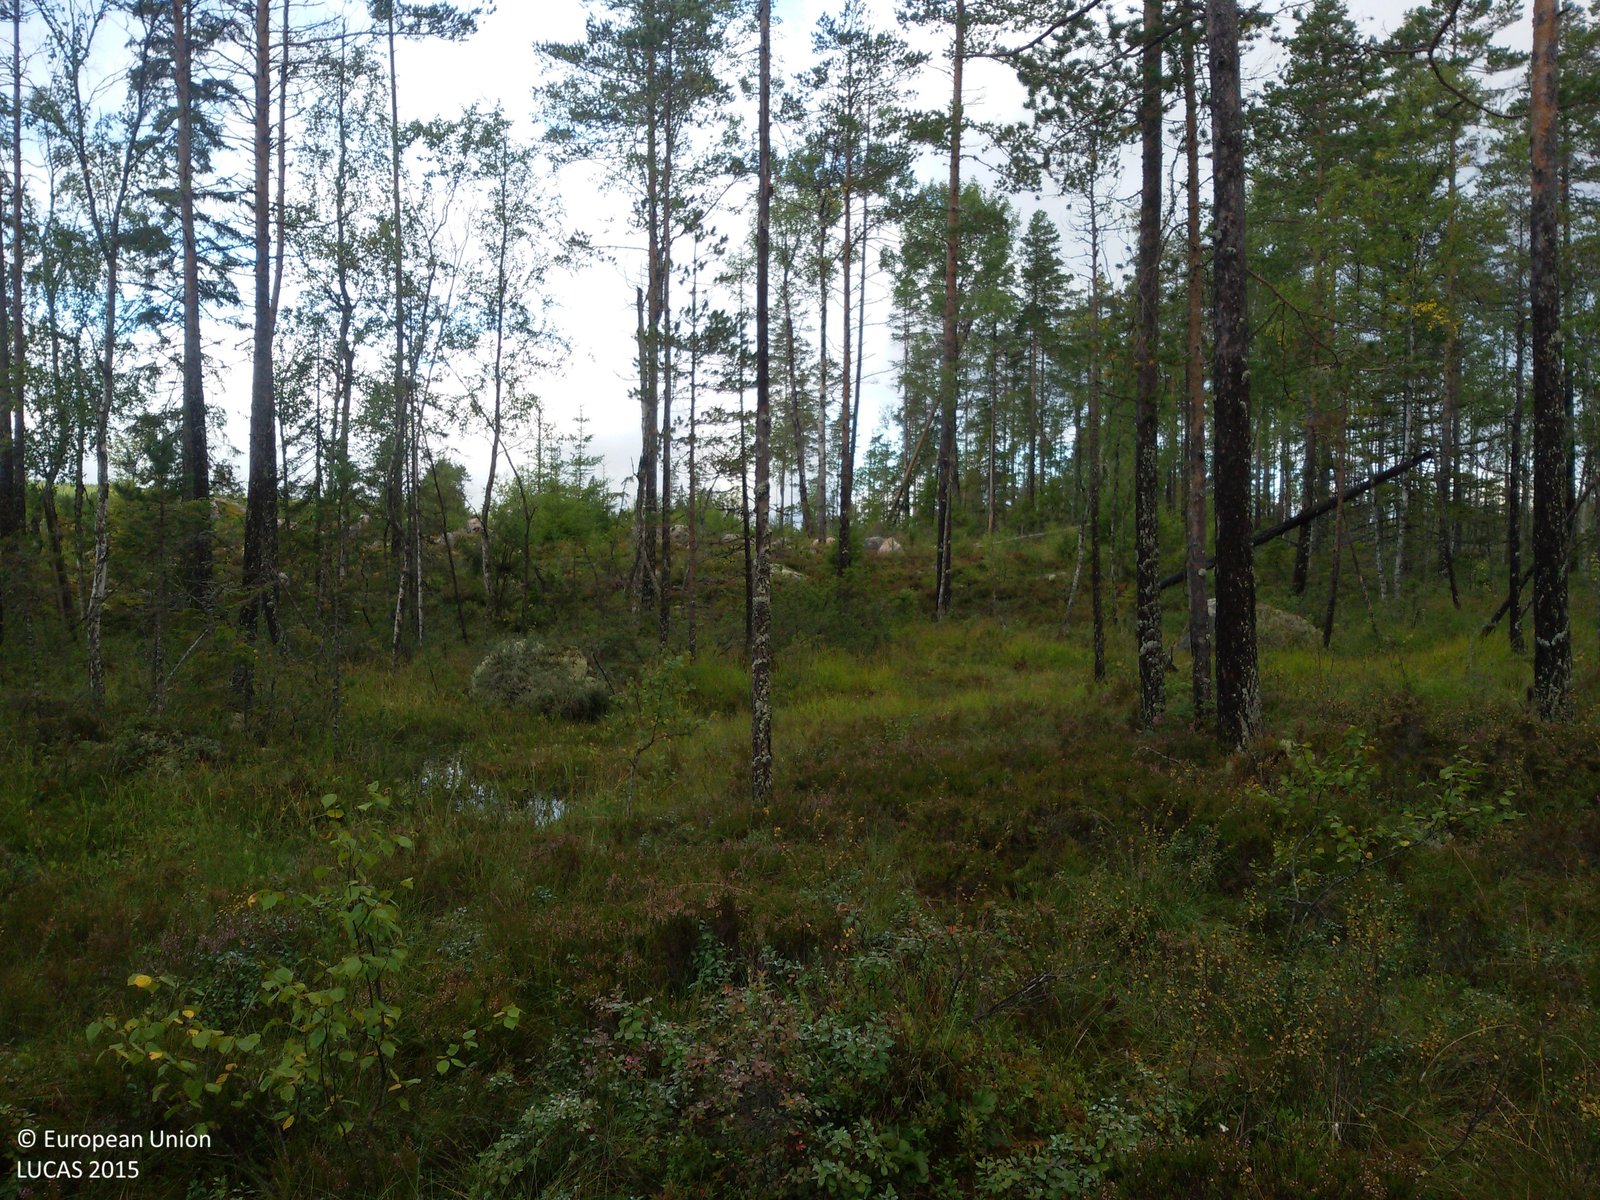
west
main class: Woodland
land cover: Pine dominated mixed woodland
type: boreal forest
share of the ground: 50 - 75 %
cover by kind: herbaceous plants 40 %, coniferous forest trees 30 %, broadleaved forest trees 30 %
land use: Forestry
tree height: > 5 m
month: September
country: SE
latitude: 61.0724
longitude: 15.3417
